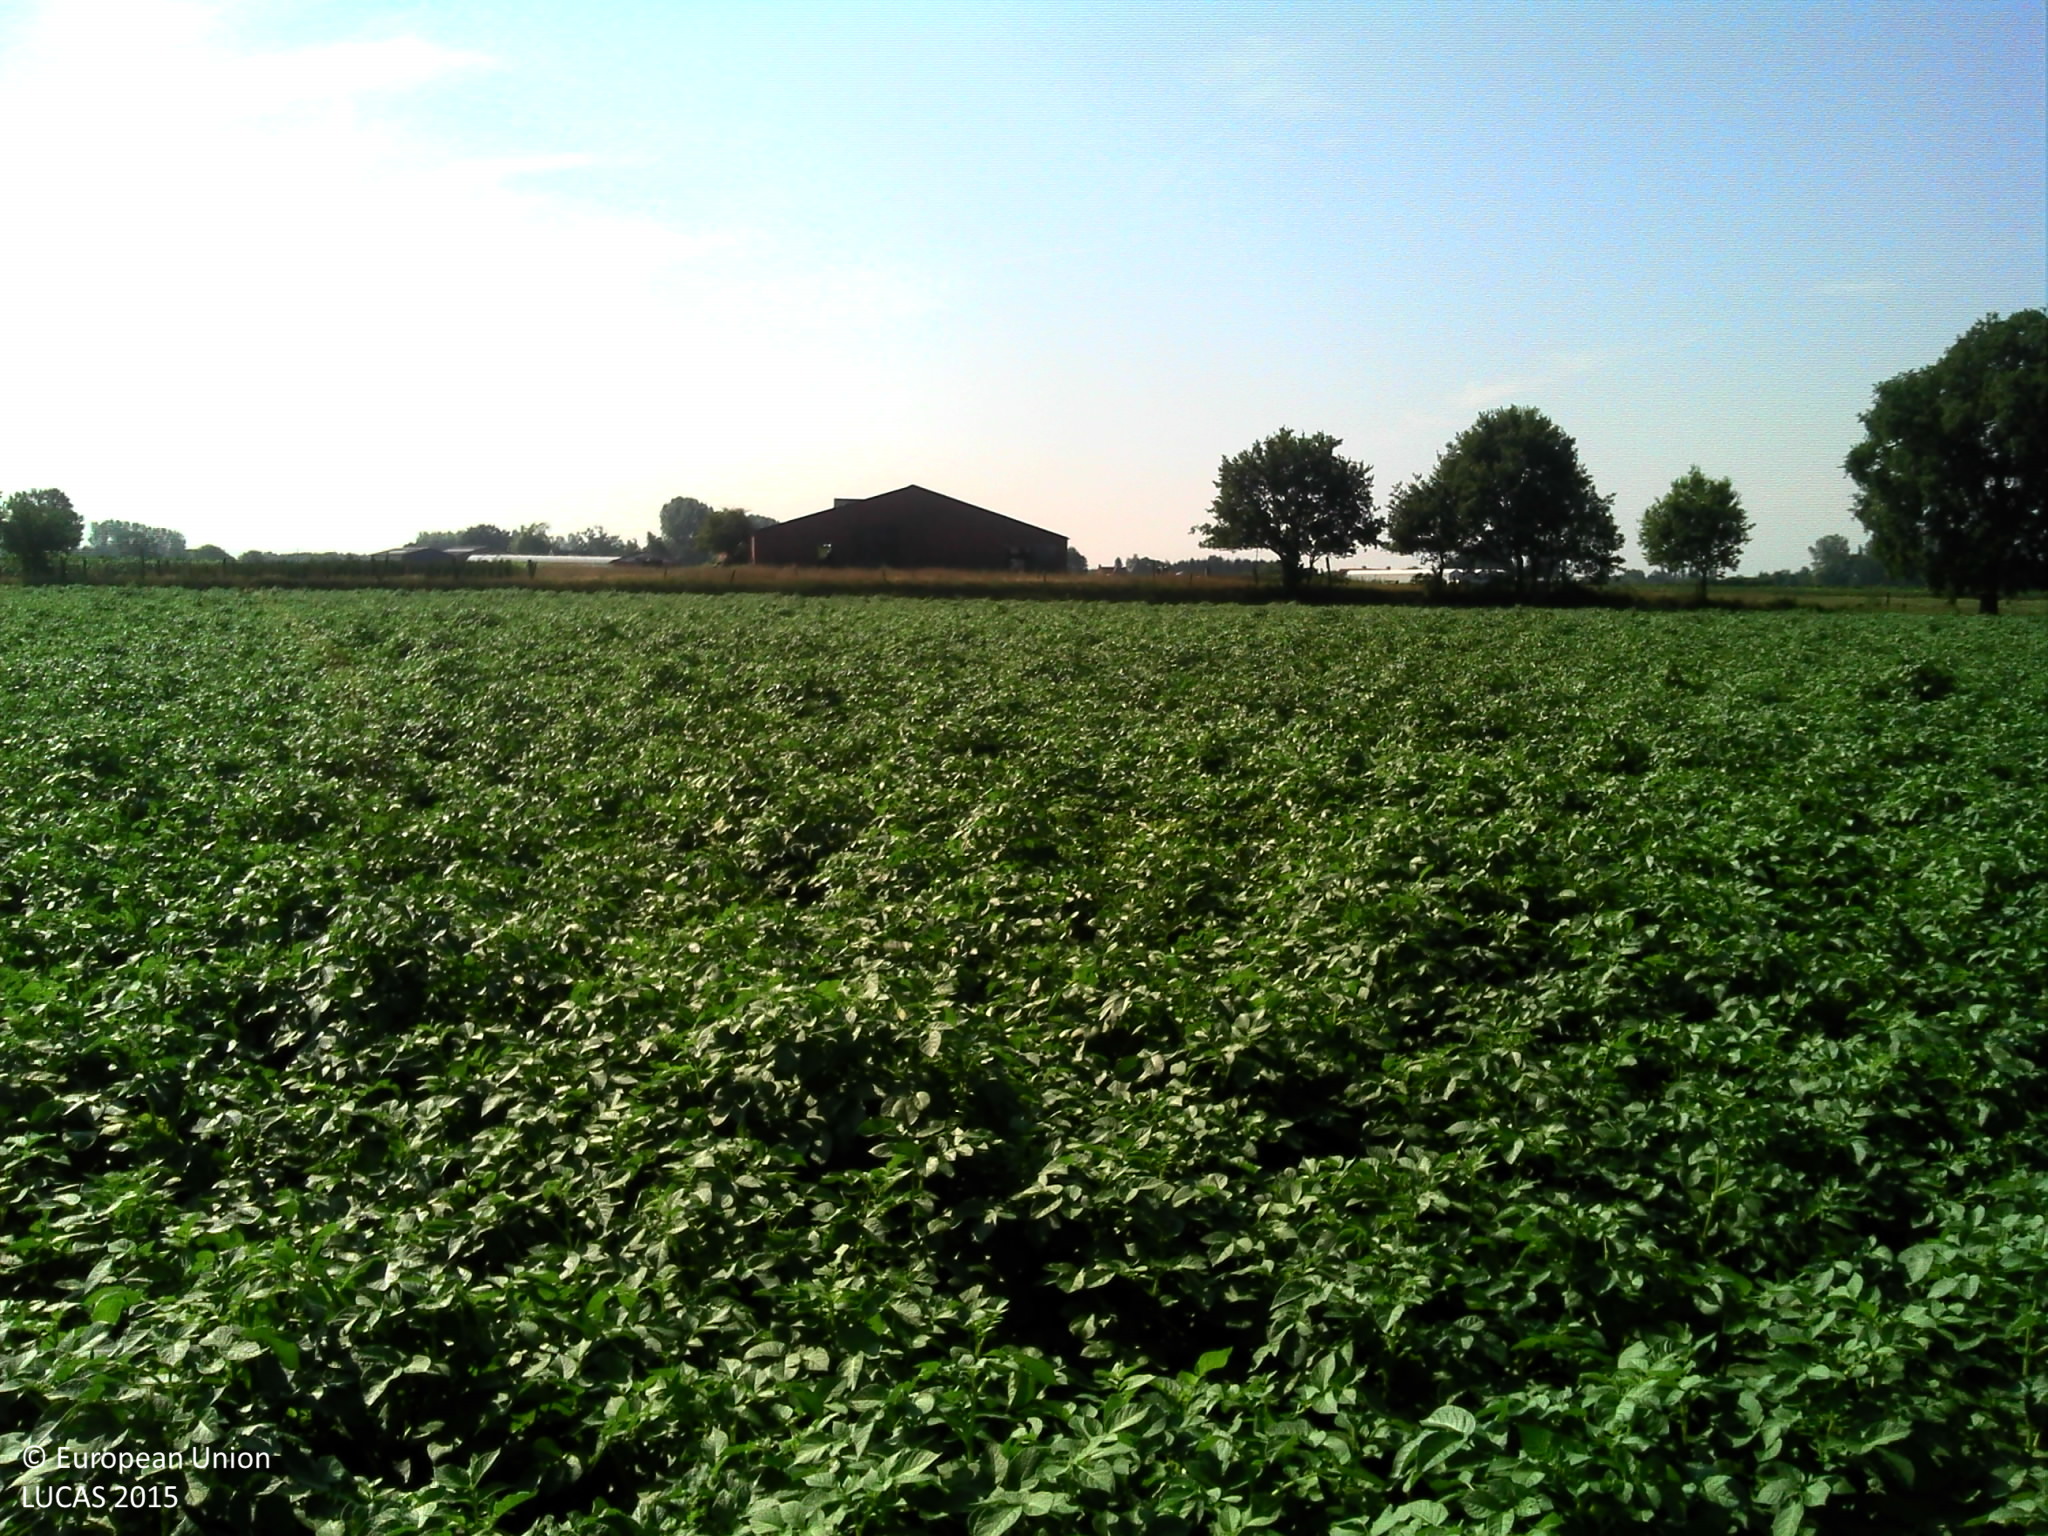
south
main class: Cropland
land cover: Potatoes
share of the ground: > 75 %
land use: Agriculture (excluding fallow land and kitchen gardens)
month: August
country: BE
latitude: 51.2682
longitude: 5.1099
